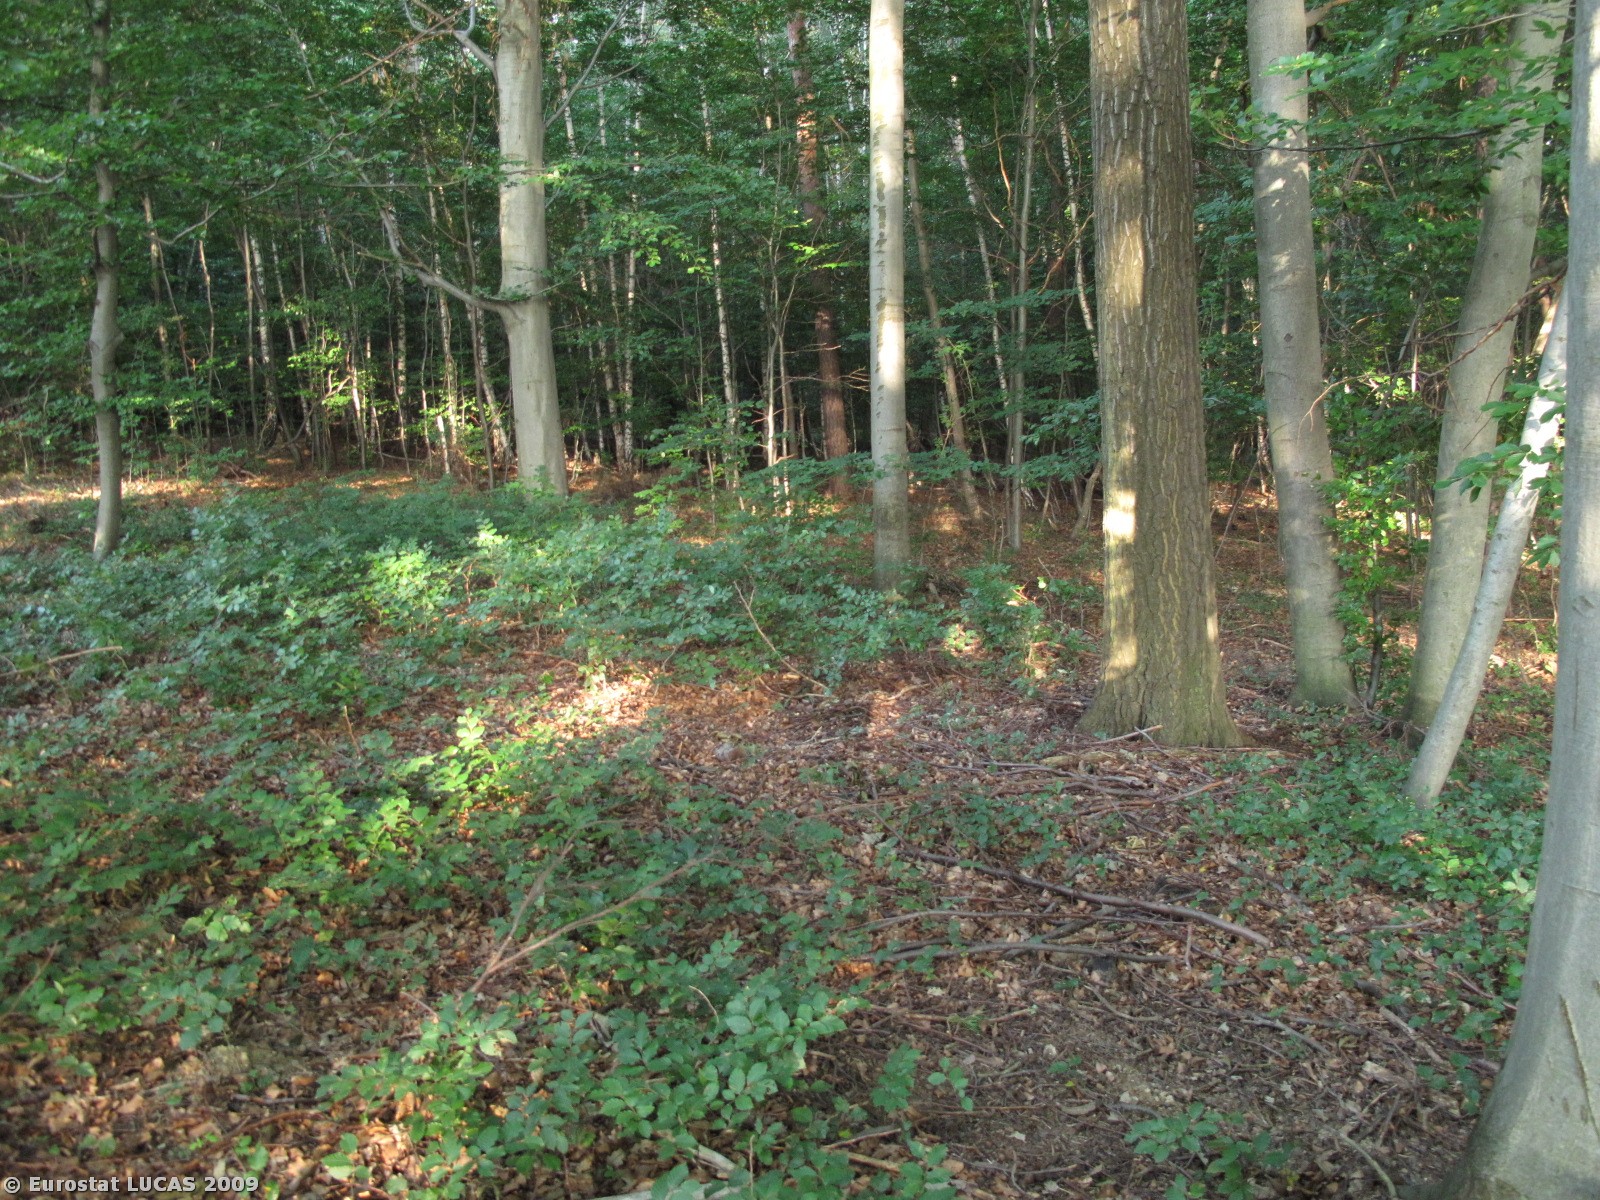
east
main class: Woodland
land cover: Mixed woodland
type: hemiboreal forest and nemoral coniferous forest and mixed broadleaved-coniferous forest
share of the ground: > 75 %
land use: Forestry
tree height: > 5 m
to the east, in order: Mixed woodland; Tracks; Mixed woodland
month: May
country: AT
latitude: 48.2049
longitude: 15.9916
